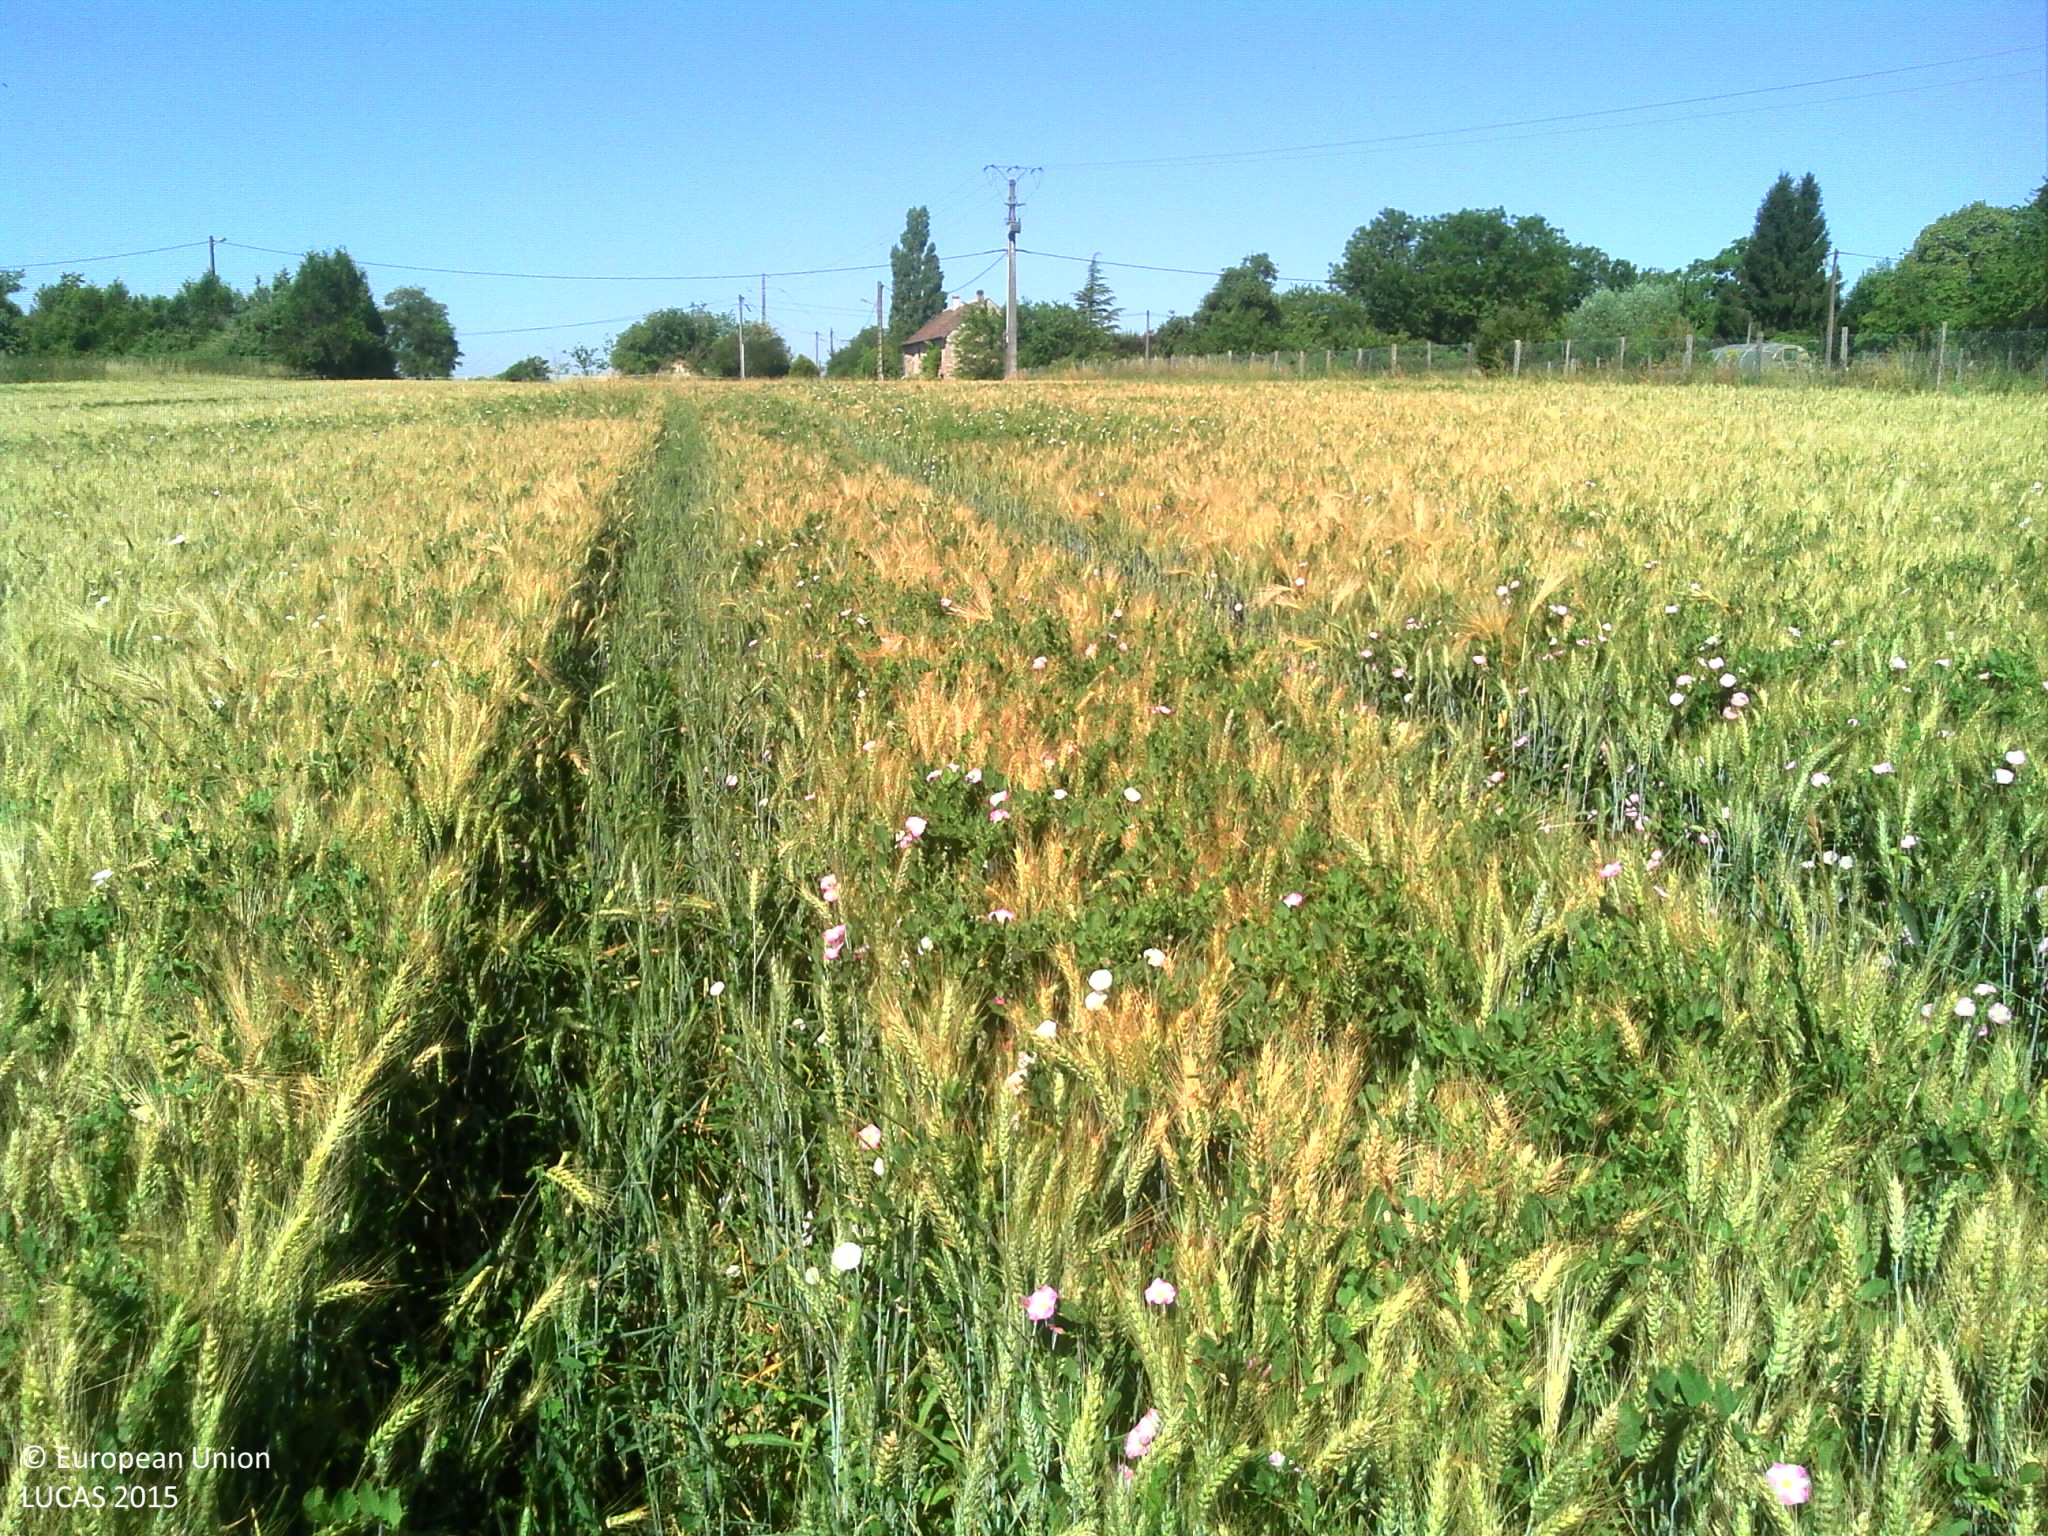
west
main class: Cropland
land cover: Common wheat
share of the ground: > 75 %
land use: Agriculture (excluding fallow land and kitchen gardens)
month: June
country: FR
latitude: 48.8746
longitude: 3.4076
